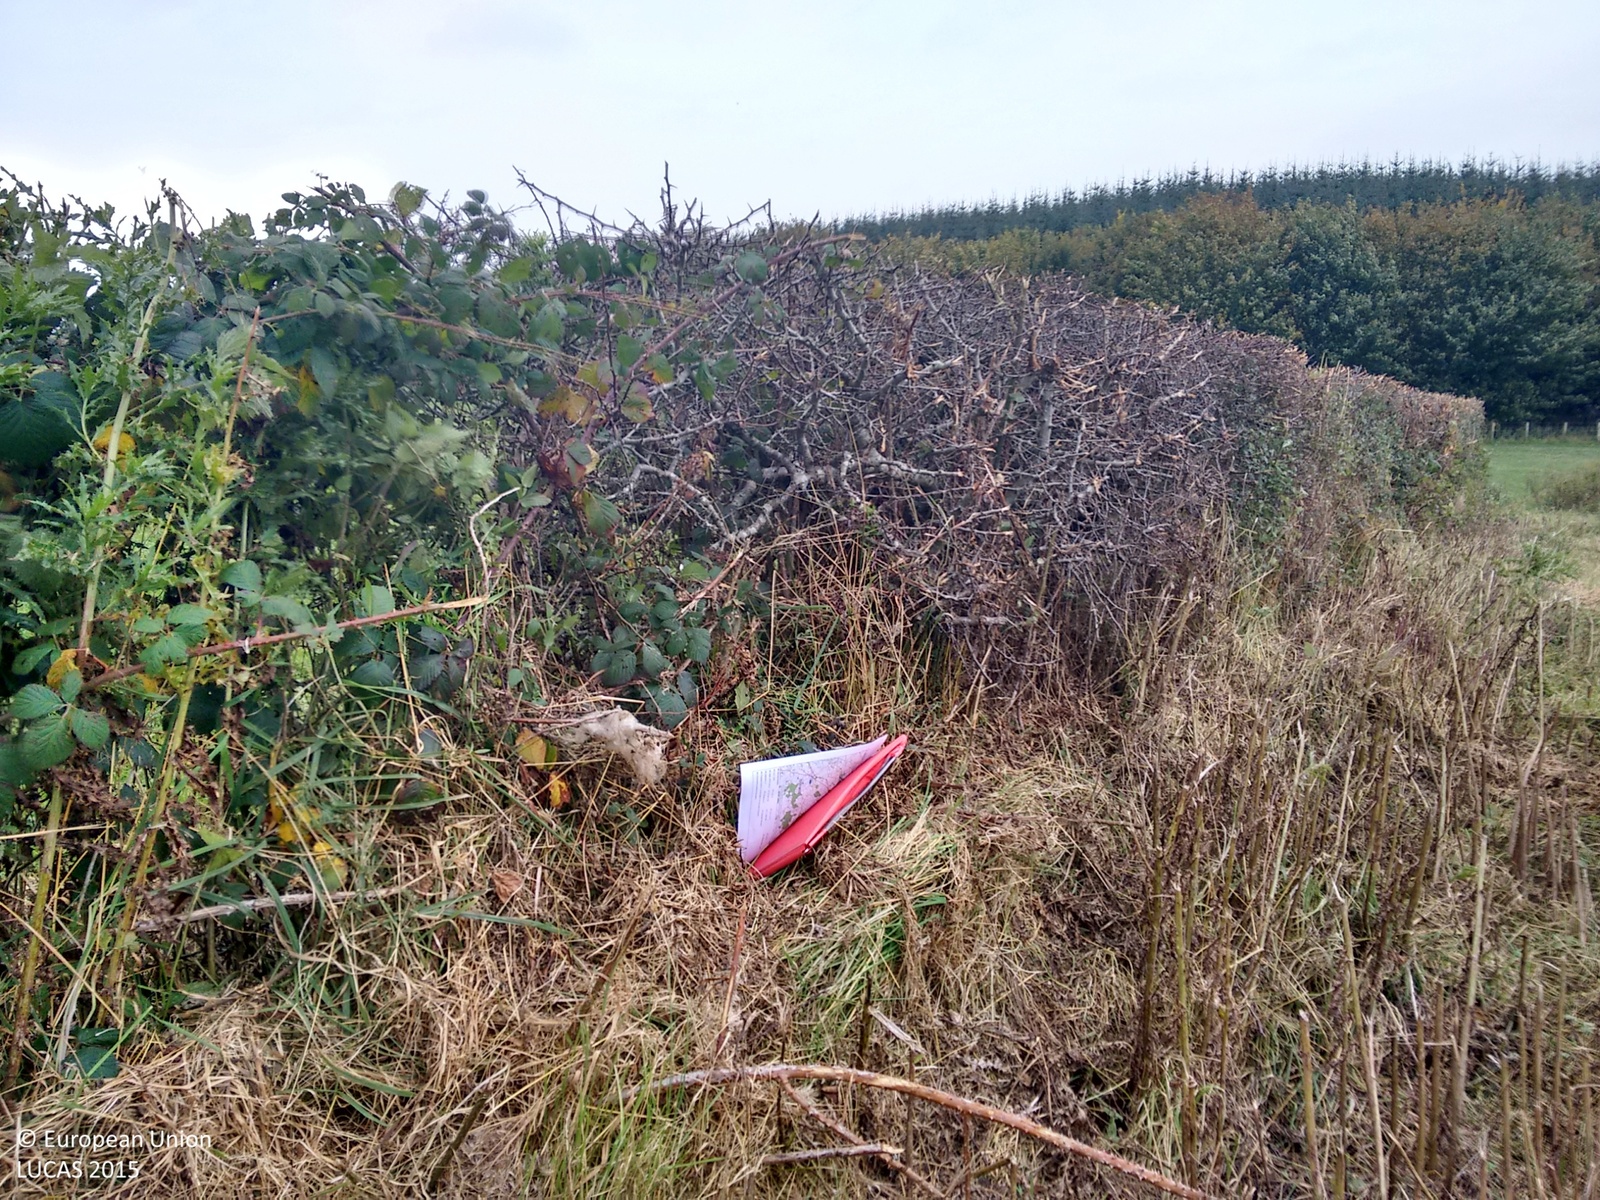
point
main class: Grassland
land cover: Grassland without tree/shrub cover
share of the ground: > 75 %
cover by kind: herbaceous plants 100 %
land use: Agriculture (excluding fallow land and kitchen gardens)
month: October
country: GB
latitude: 54.3267
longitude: -7.3577
